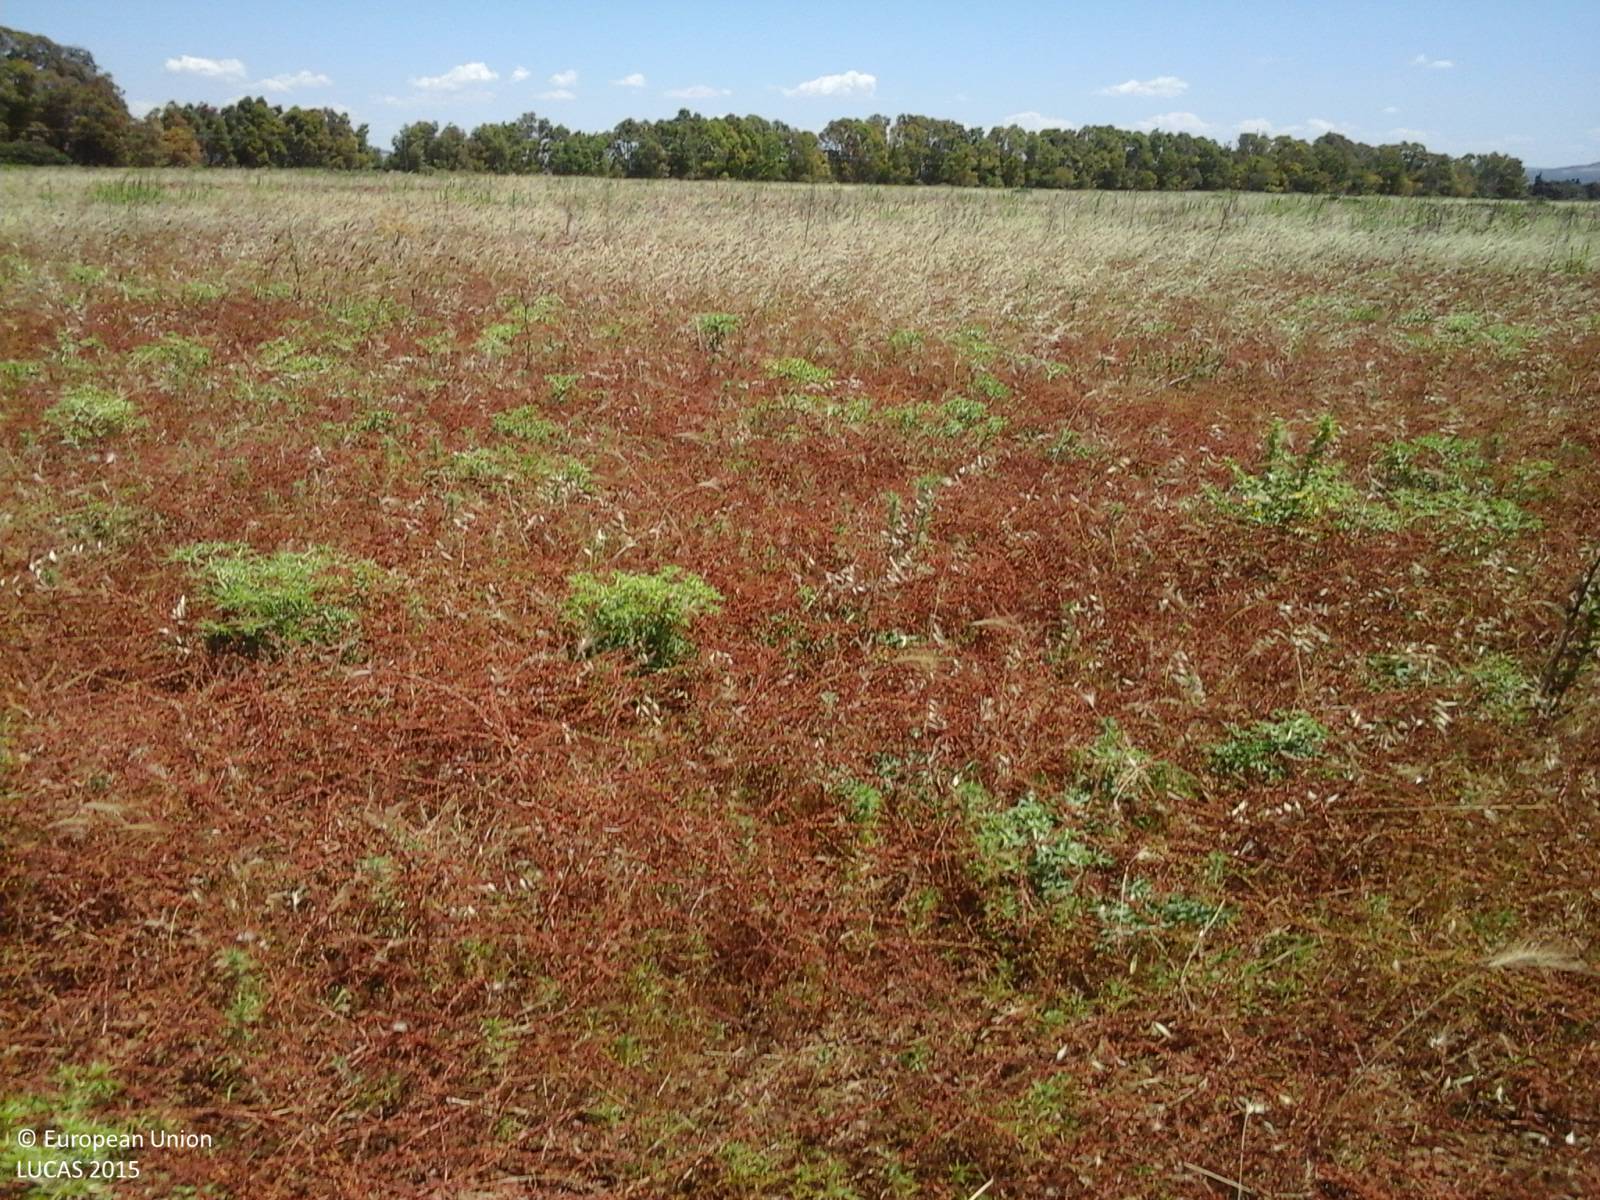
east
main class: Grassland
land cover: Spontaneously vegetated surfaces
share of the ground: > 75 %
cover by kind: herbaceous plants 100 %
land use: Fallow land
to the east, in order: Spontaneously vegetated surfaces; Fences; Spontaneously vegetated surfaces; Electric lines; Spontaneously vegetated surfaces; Fences; Dry stone walls; Grass margins; Tracks; Fences; Lines of trees; Lucerne
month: June
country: IT
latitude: 40.6154
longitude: 8.3415
